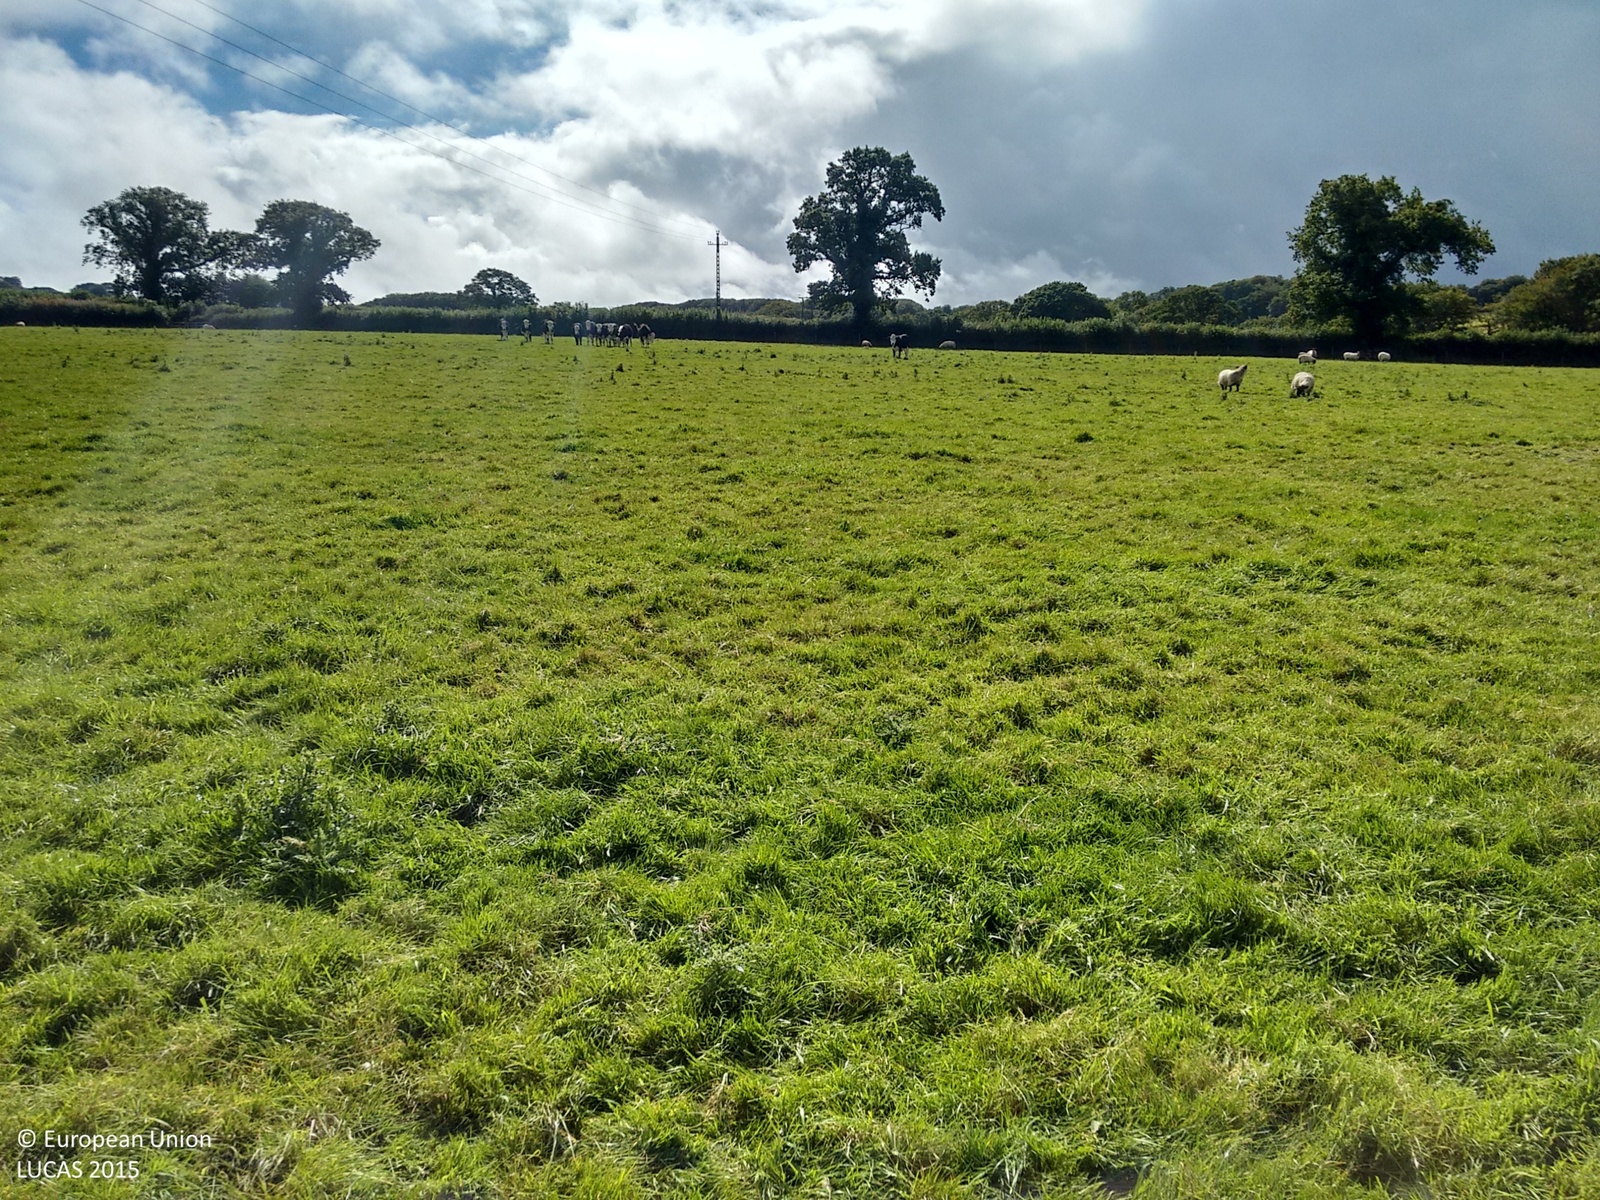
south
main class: Grassland
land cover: Grassland without tree/shrub cover
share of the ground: > 75 %
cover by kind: herbaceous plants 100 %
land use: Agriculture (excluding fallow land and kitchen gardens)
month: September
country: GB
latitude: 50.6730
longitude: -4.0903
